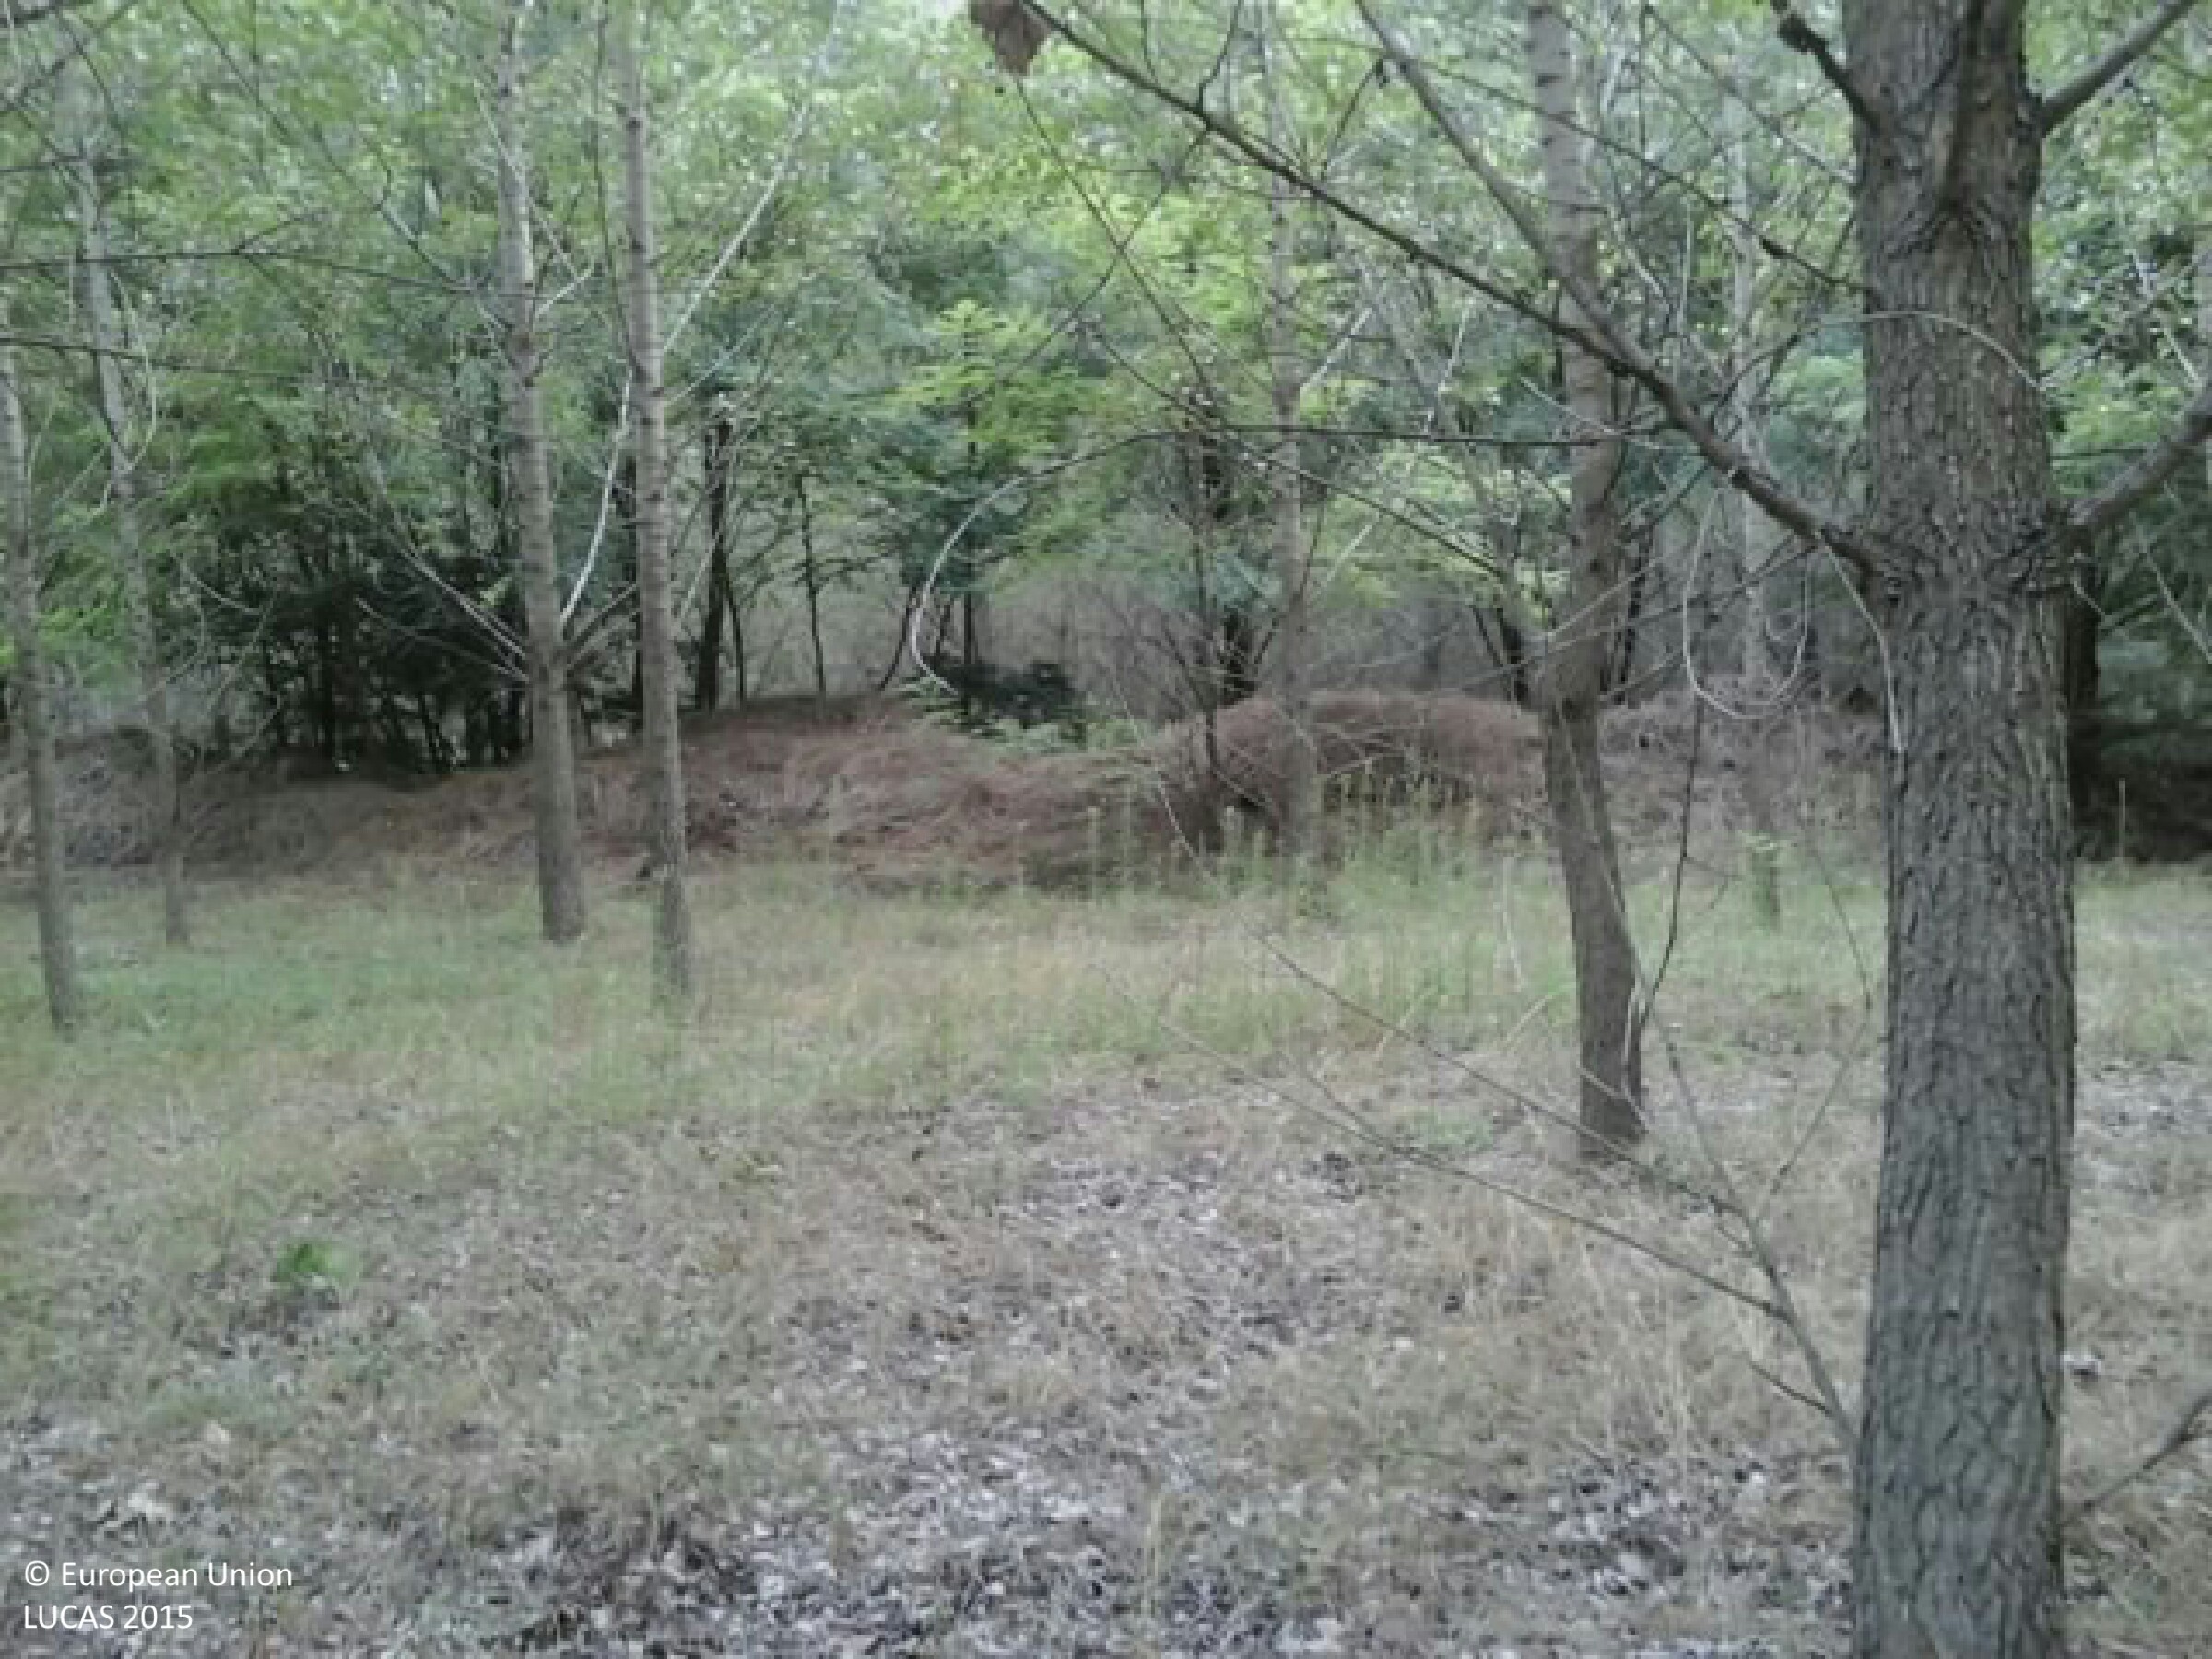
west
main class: Woodland
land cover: Broadleaved woodland
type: mesophytic deciduous forest
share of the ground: > 75 %
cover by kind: broadleaved forest trees 80 %, herbaceous plants 20 %
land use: Forestry
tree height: > 5 m
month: July
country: HU
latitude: 47.1257
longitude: 19.6840
